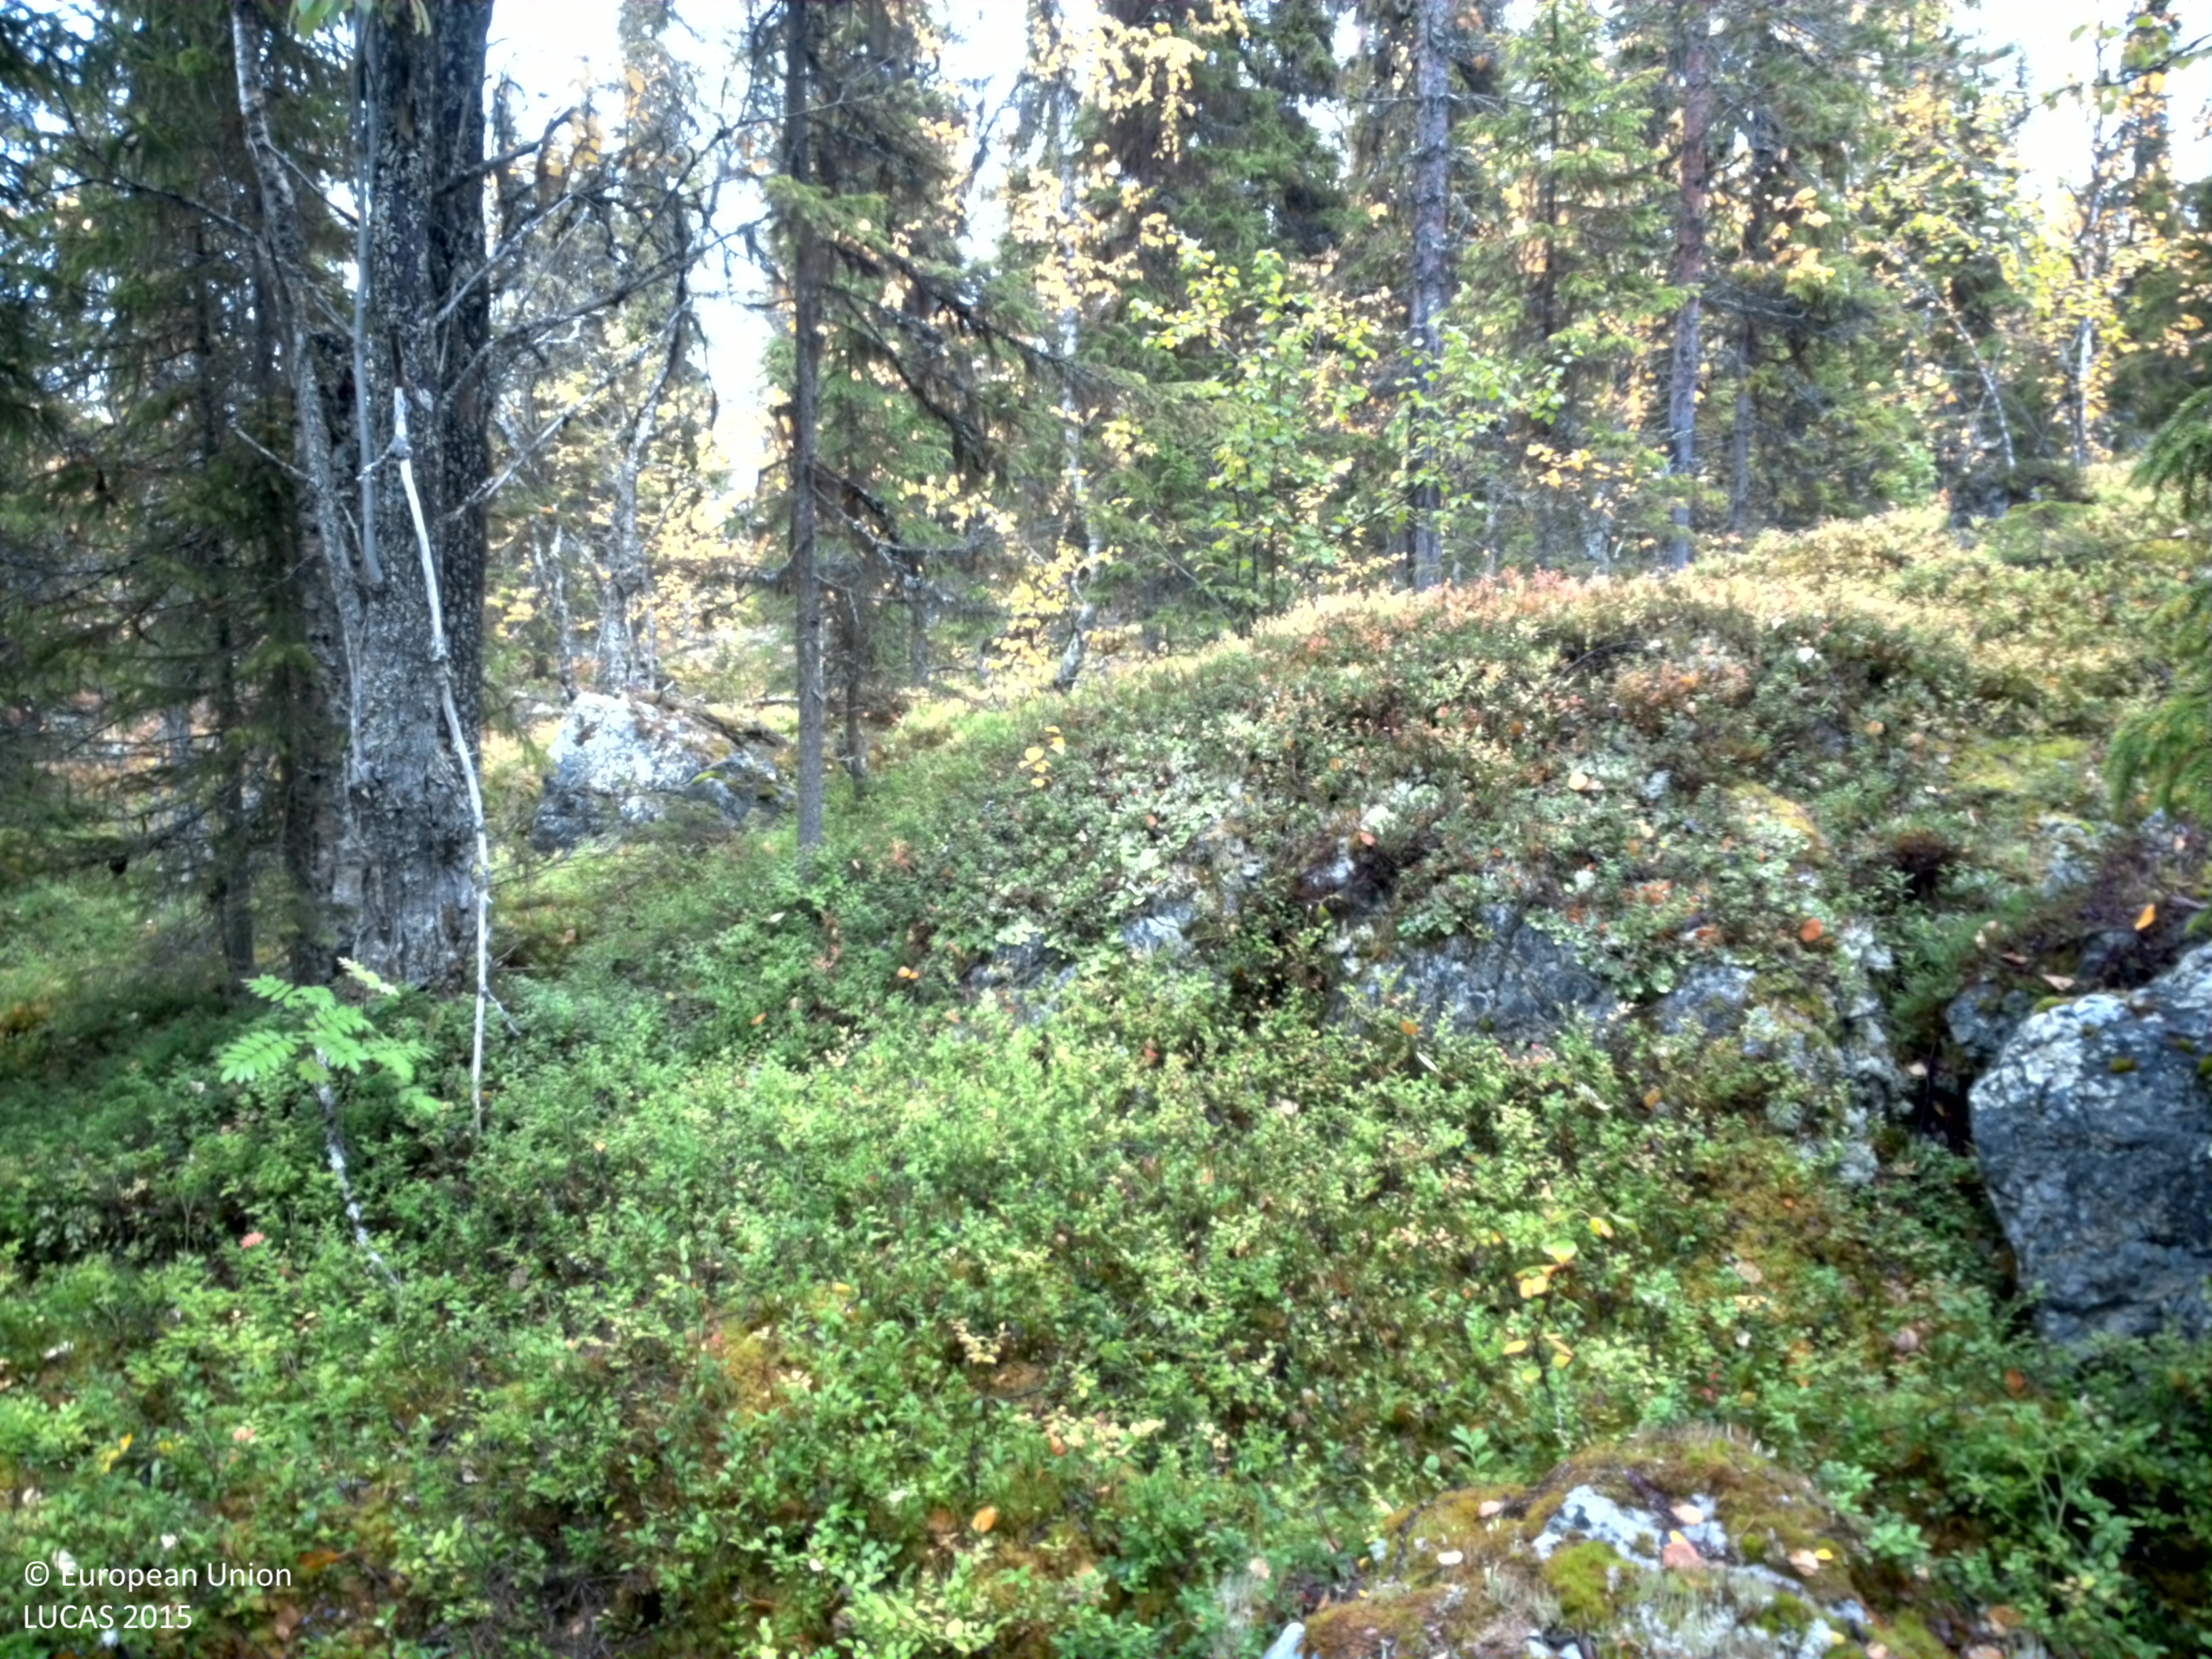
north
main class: Woodland
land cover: Spruce dominated coniferous woodland
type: boreal forest
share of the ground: 25 - 50 %
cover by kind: coniferous forest trees 35 %, shrubs 30 %, lichens and mosses 25 %, broadleaved forest trees 10 %
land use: Forestry
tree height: > 5 m
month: September
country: SE
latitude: 65.1102
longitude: 16.6714
